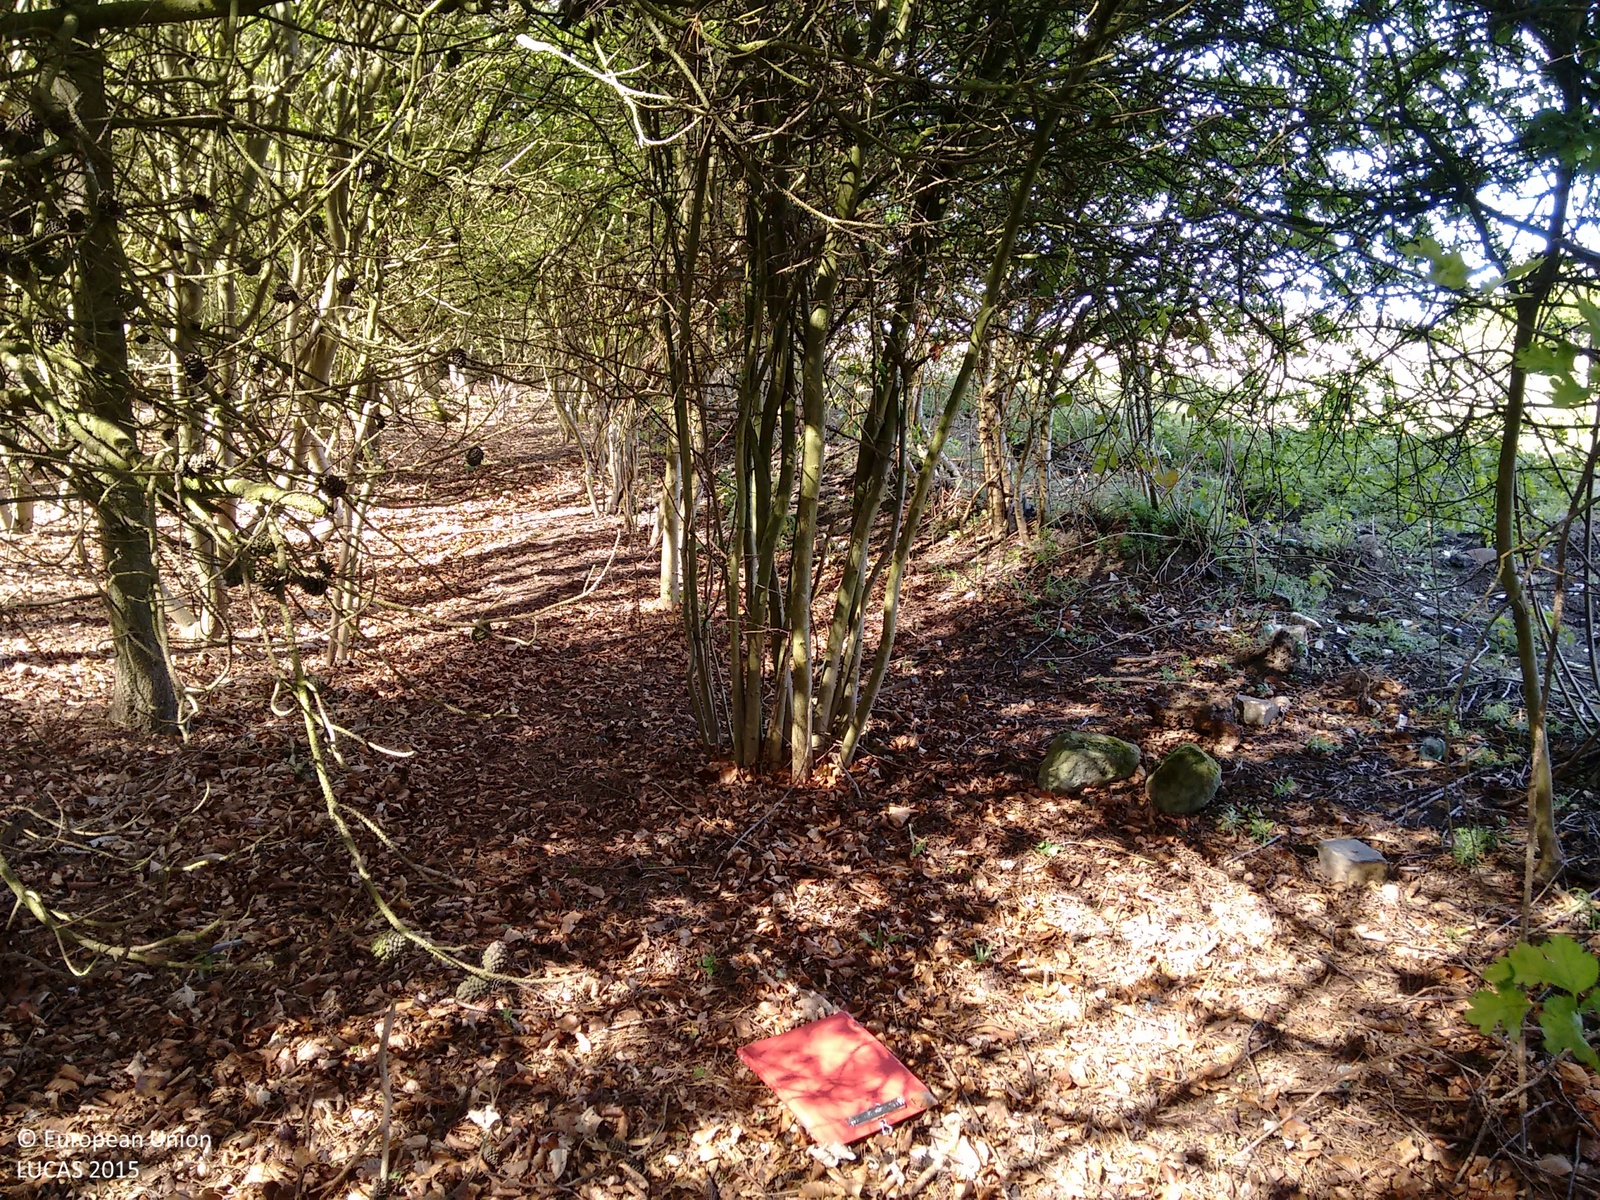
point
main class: Woodland
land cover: Other mixed woodland
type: hemiboreal forest and nemoral coniferous forest and mixed broadleaved-coniferous forest
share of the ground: > 75 %
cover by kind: broadleaved forest trees 70 %, coniferous forest trees 30 %
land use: Forestry
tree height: > 5 m
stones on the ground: < 10 %
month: May
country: GB
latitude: 55.0842
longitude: -1.5305
